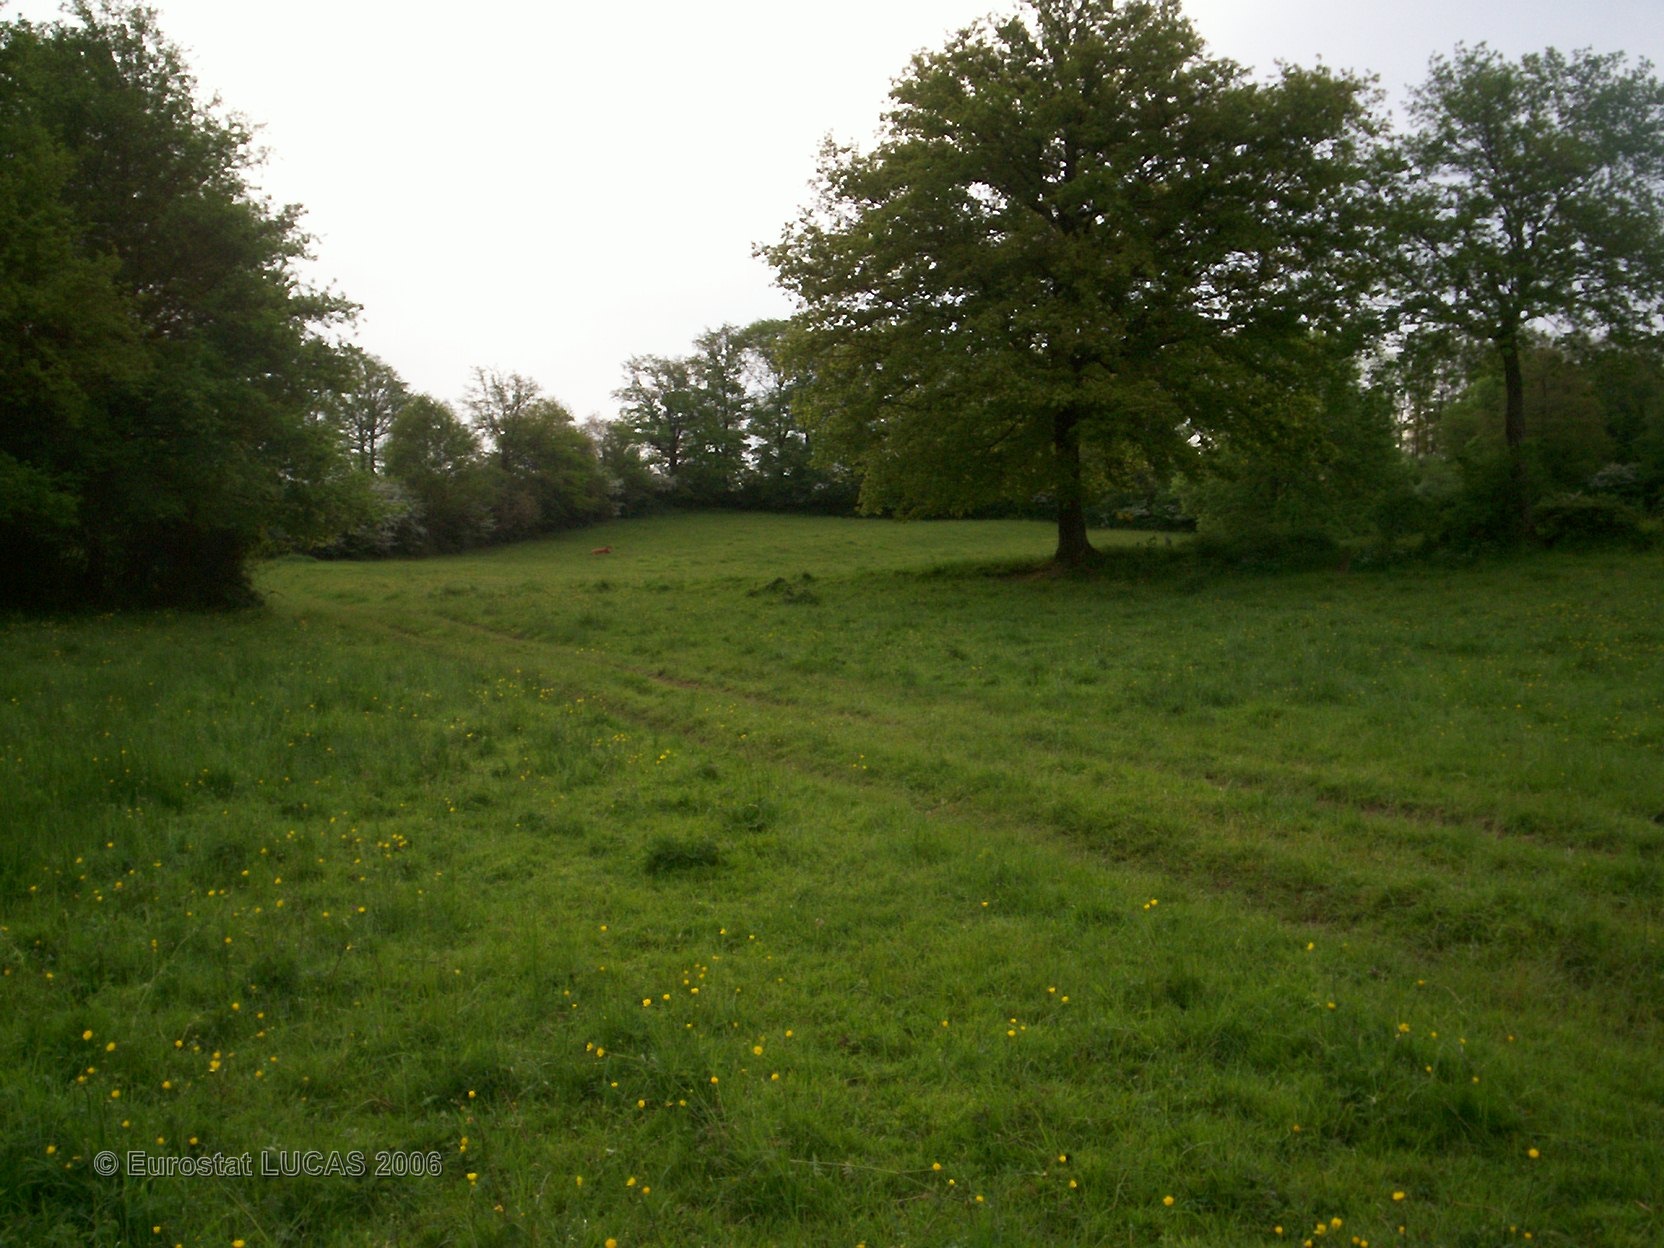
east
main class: Grassland
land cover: Grassland without tree/shrub cover
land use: Agriculture (excluding fallow land and kitchen gardens)
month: May
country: FR
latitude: 46.1465
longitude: 1.1462
